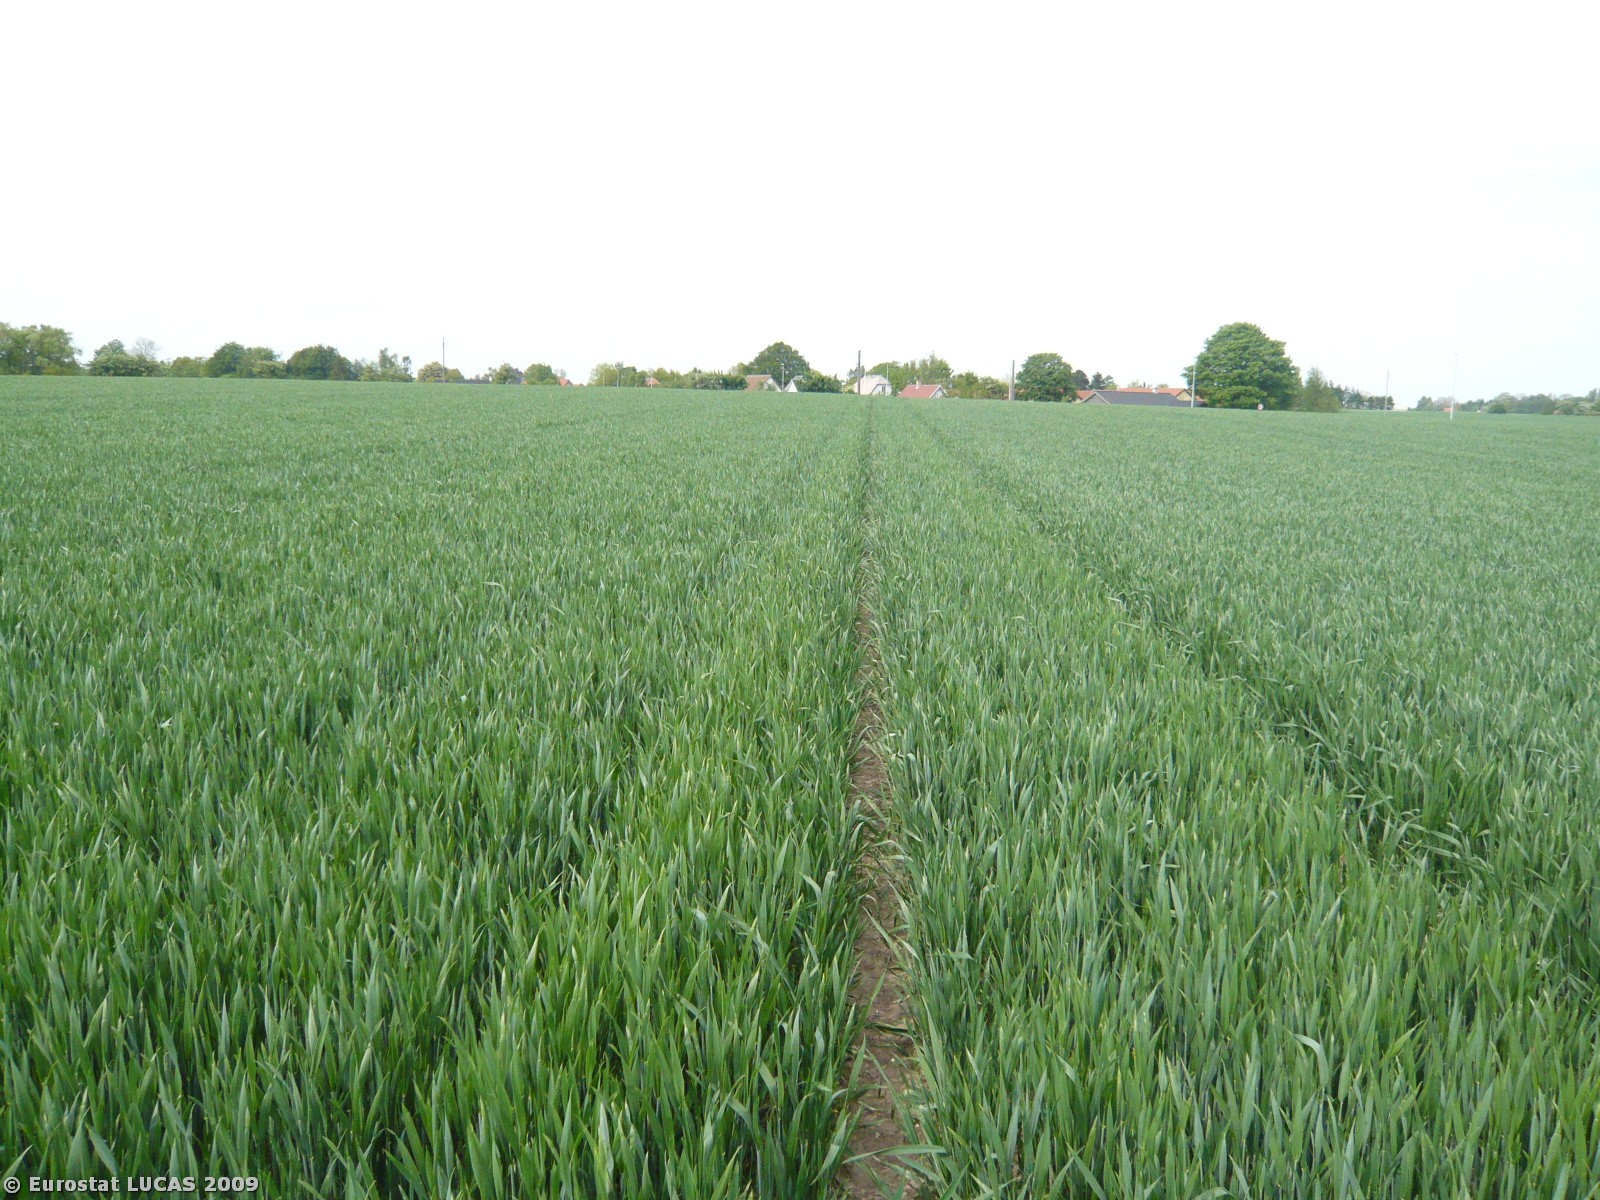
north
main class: Cropland
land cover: Common wheat
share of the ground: > 75 %
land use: Agriculture (excluding fallow land and kitchen gardens)
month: May
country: DK
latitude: 55.3834
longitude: 11.8453
